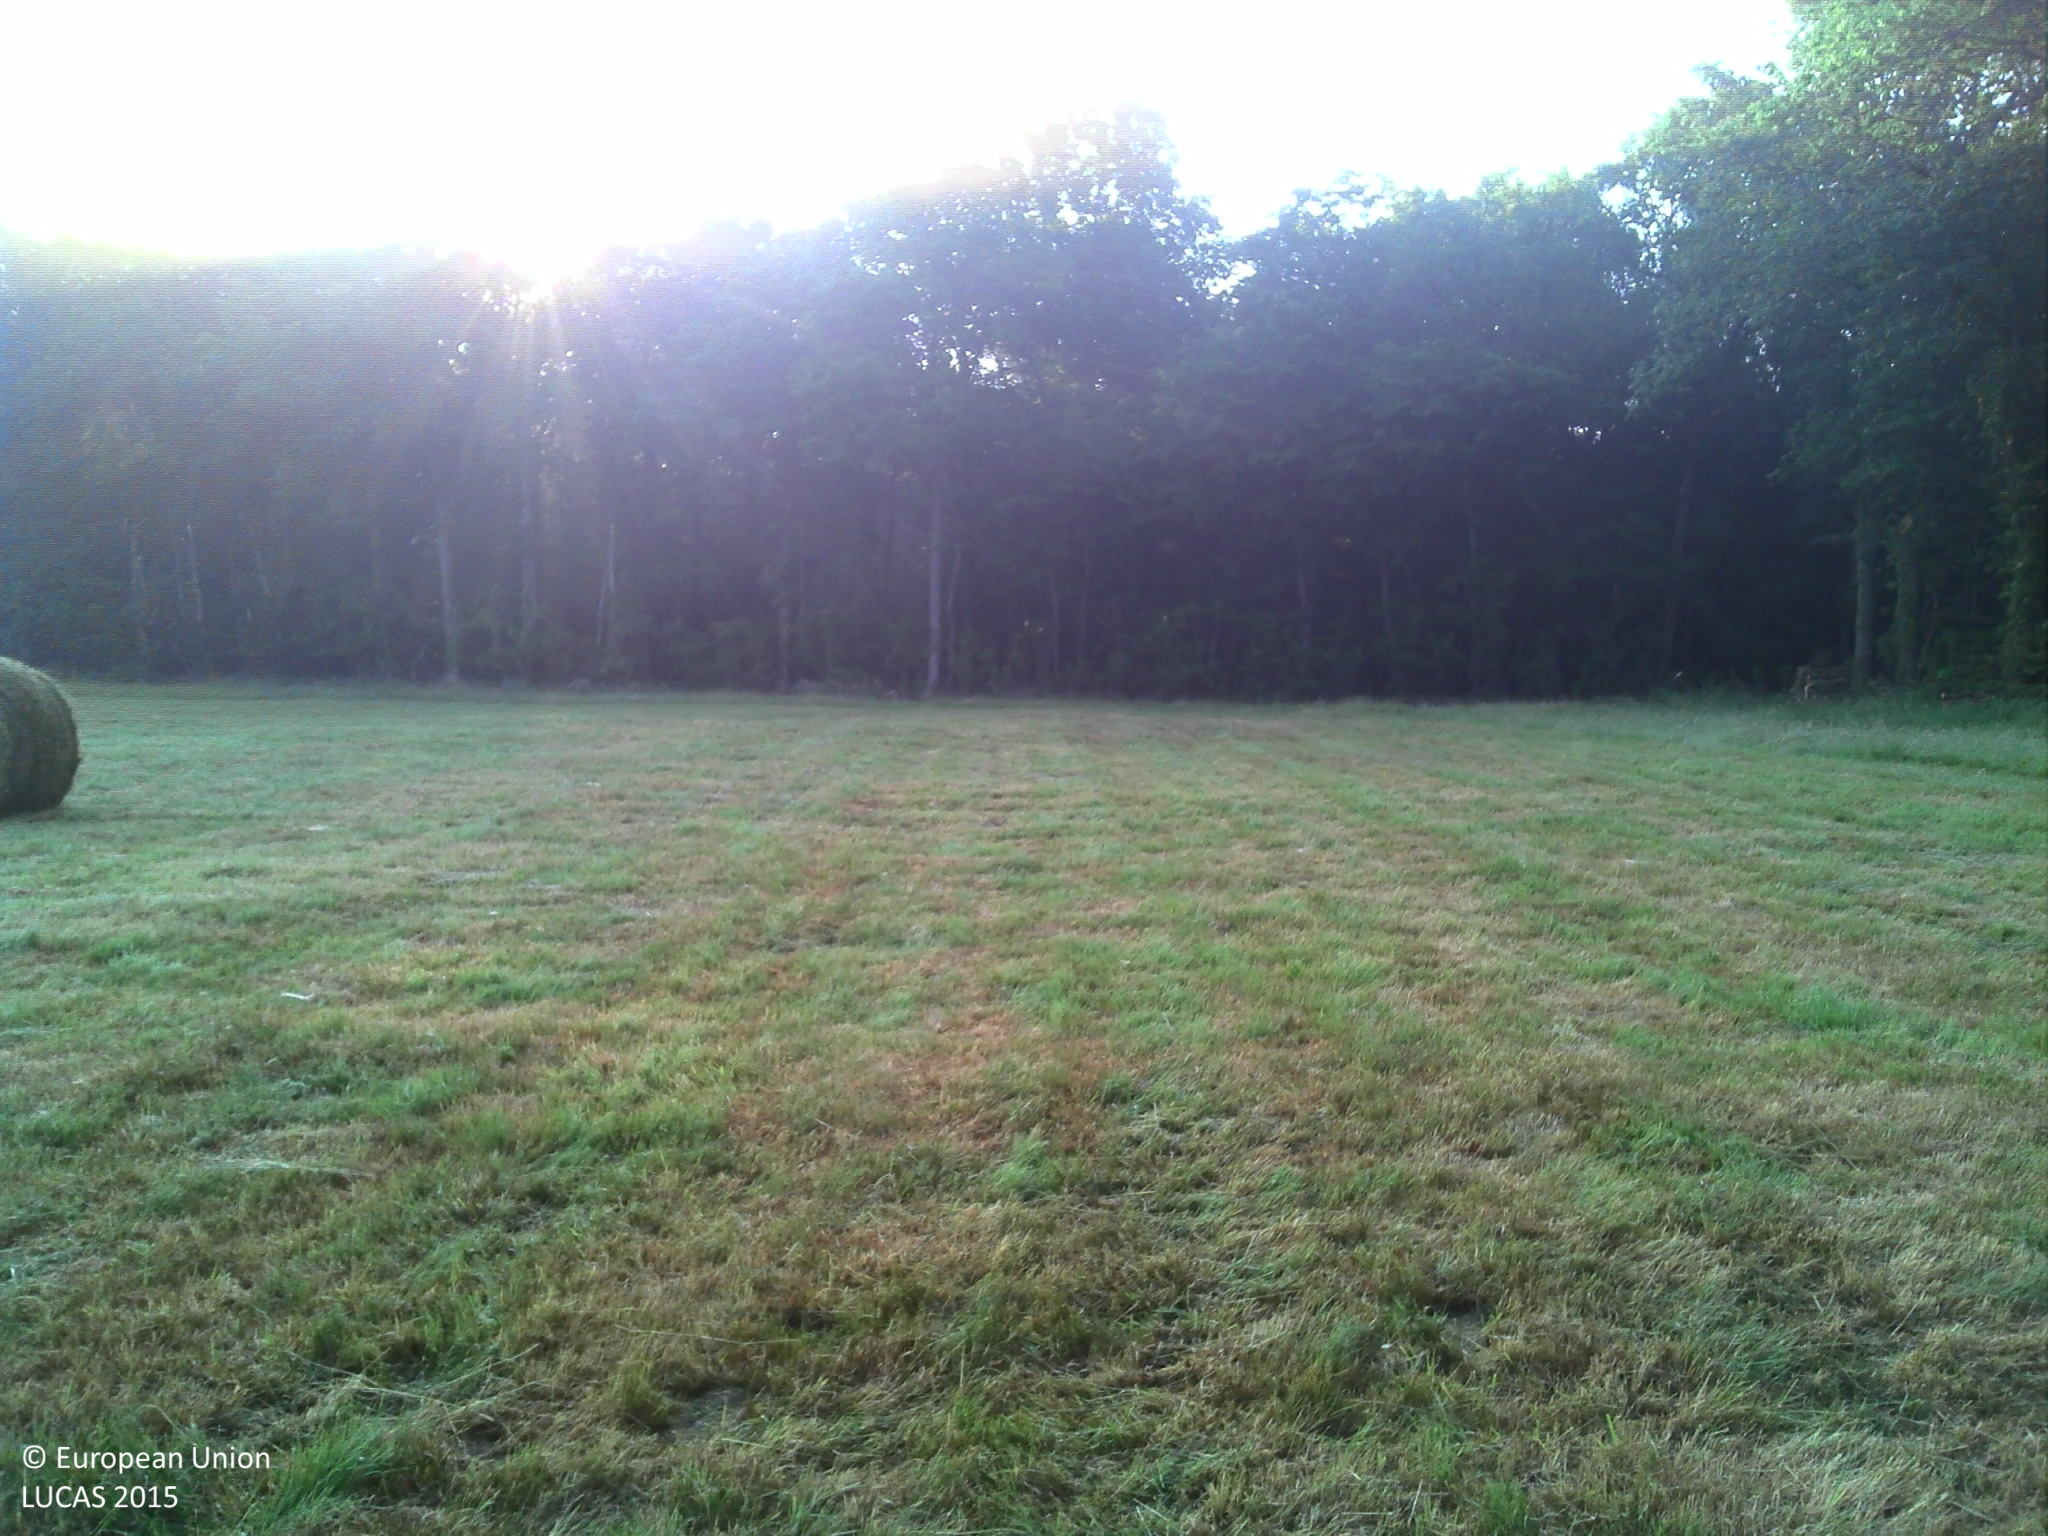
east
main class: Grassland
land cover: Grassland without tree/shrub cover
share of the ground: > 75 %
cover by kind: herbaceous plants 100 %
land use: Agriculture (excluding fallow land and kitchen gardens)
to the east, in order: Grassland without tree/shrub cover; Ditches and canals; Broadleaved woodland; Ditches and canals; Broadleaved woodland; Ditches and canals; Broadleaved woodland
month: June
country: FR
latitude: 46.7850
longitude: 2.6464
